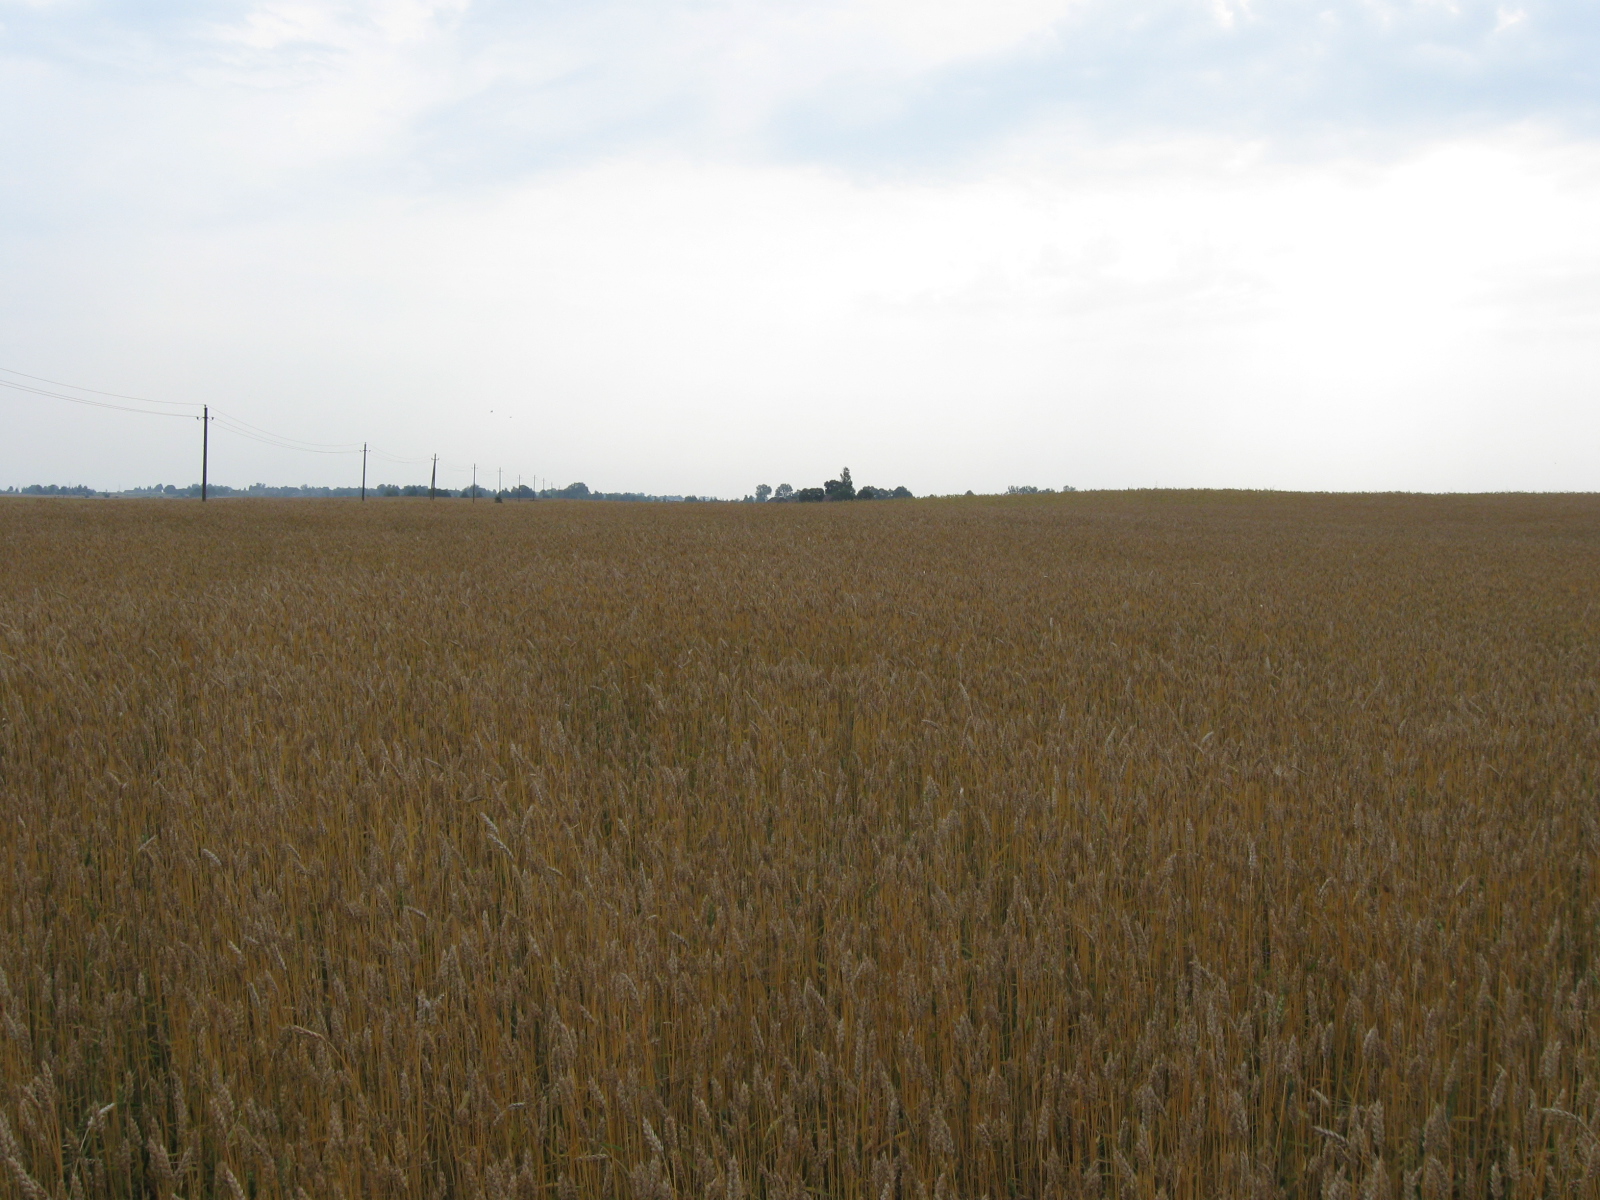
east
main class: Cropland
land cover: Common wheat
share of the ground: > 75 %
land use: Agriculture (excluding fallow land and kitchen gardens)
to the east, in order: Common wheat
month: August
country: LT
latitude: 54.5585
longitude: 23.4884
